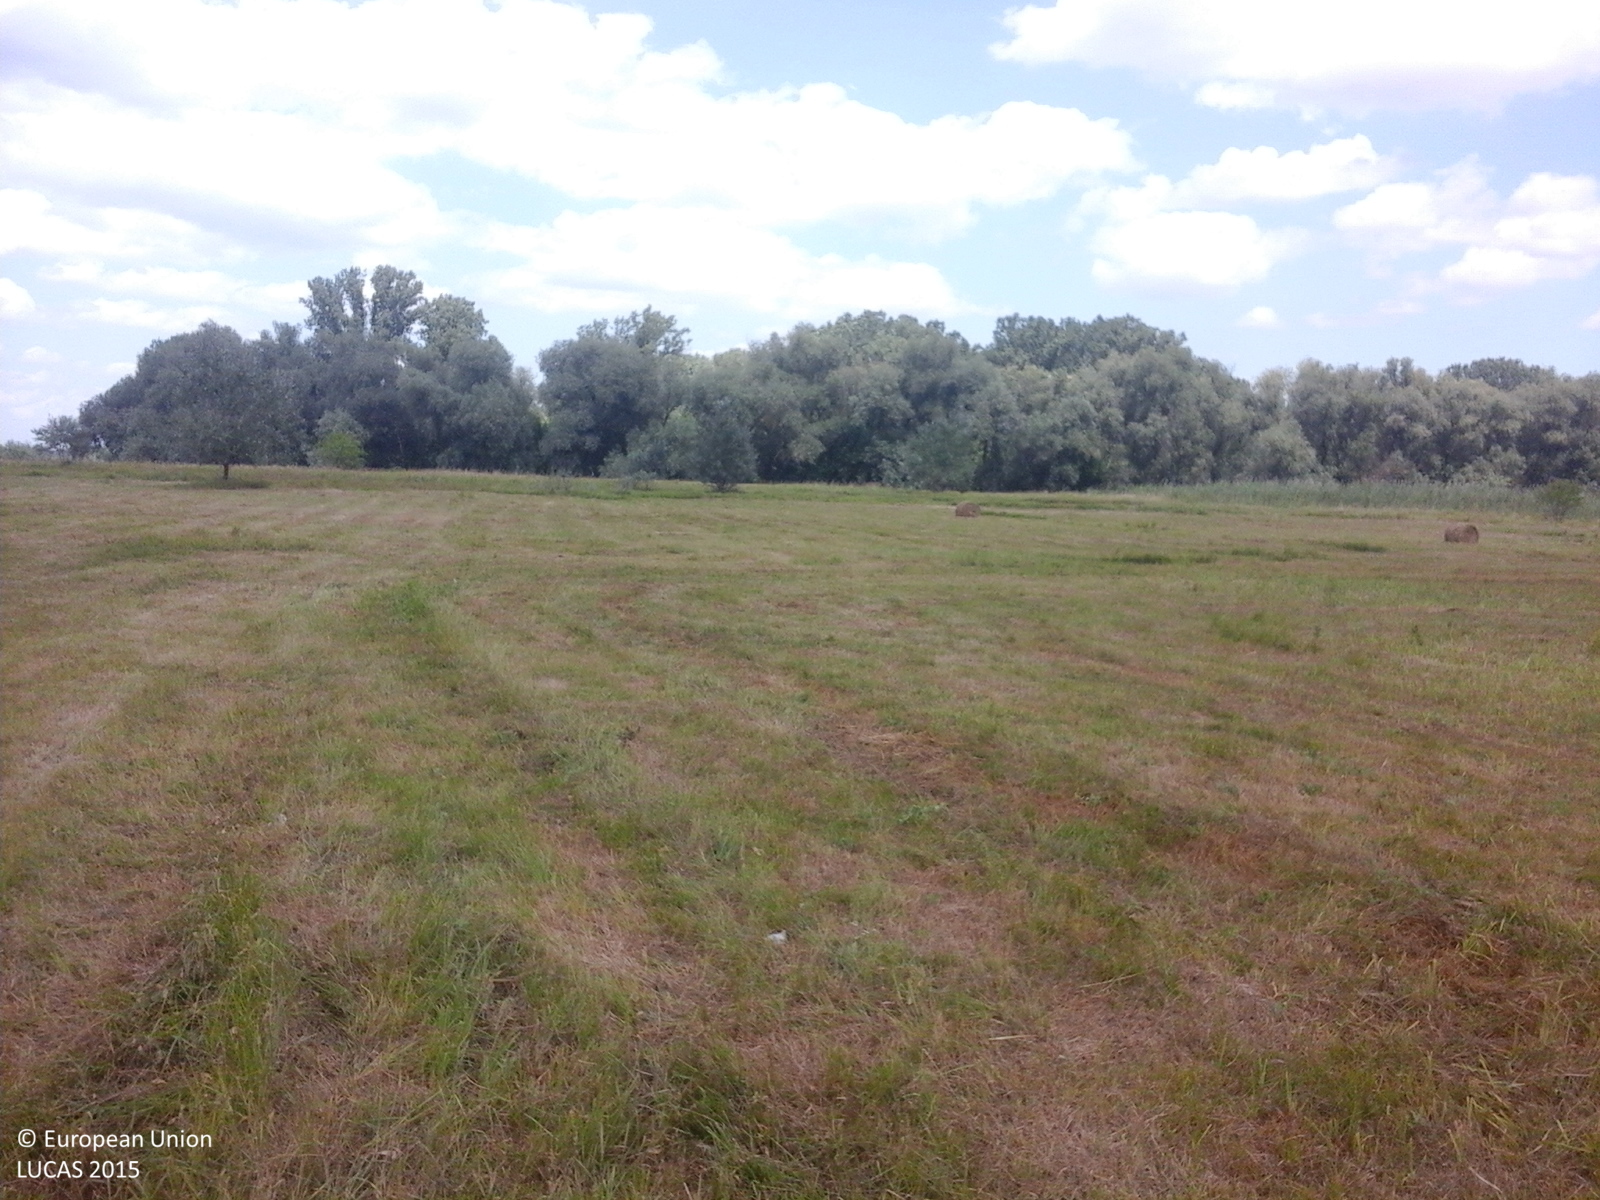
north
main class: Grassland
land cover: Grassland without tree/shrub cover
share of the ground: > 75 %
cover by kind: herbaceous plants 100 %
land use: Agriculture (excluding fallow land and kitchen gardens)
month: July
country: RO
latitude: 46.4616
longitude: 28.2465
